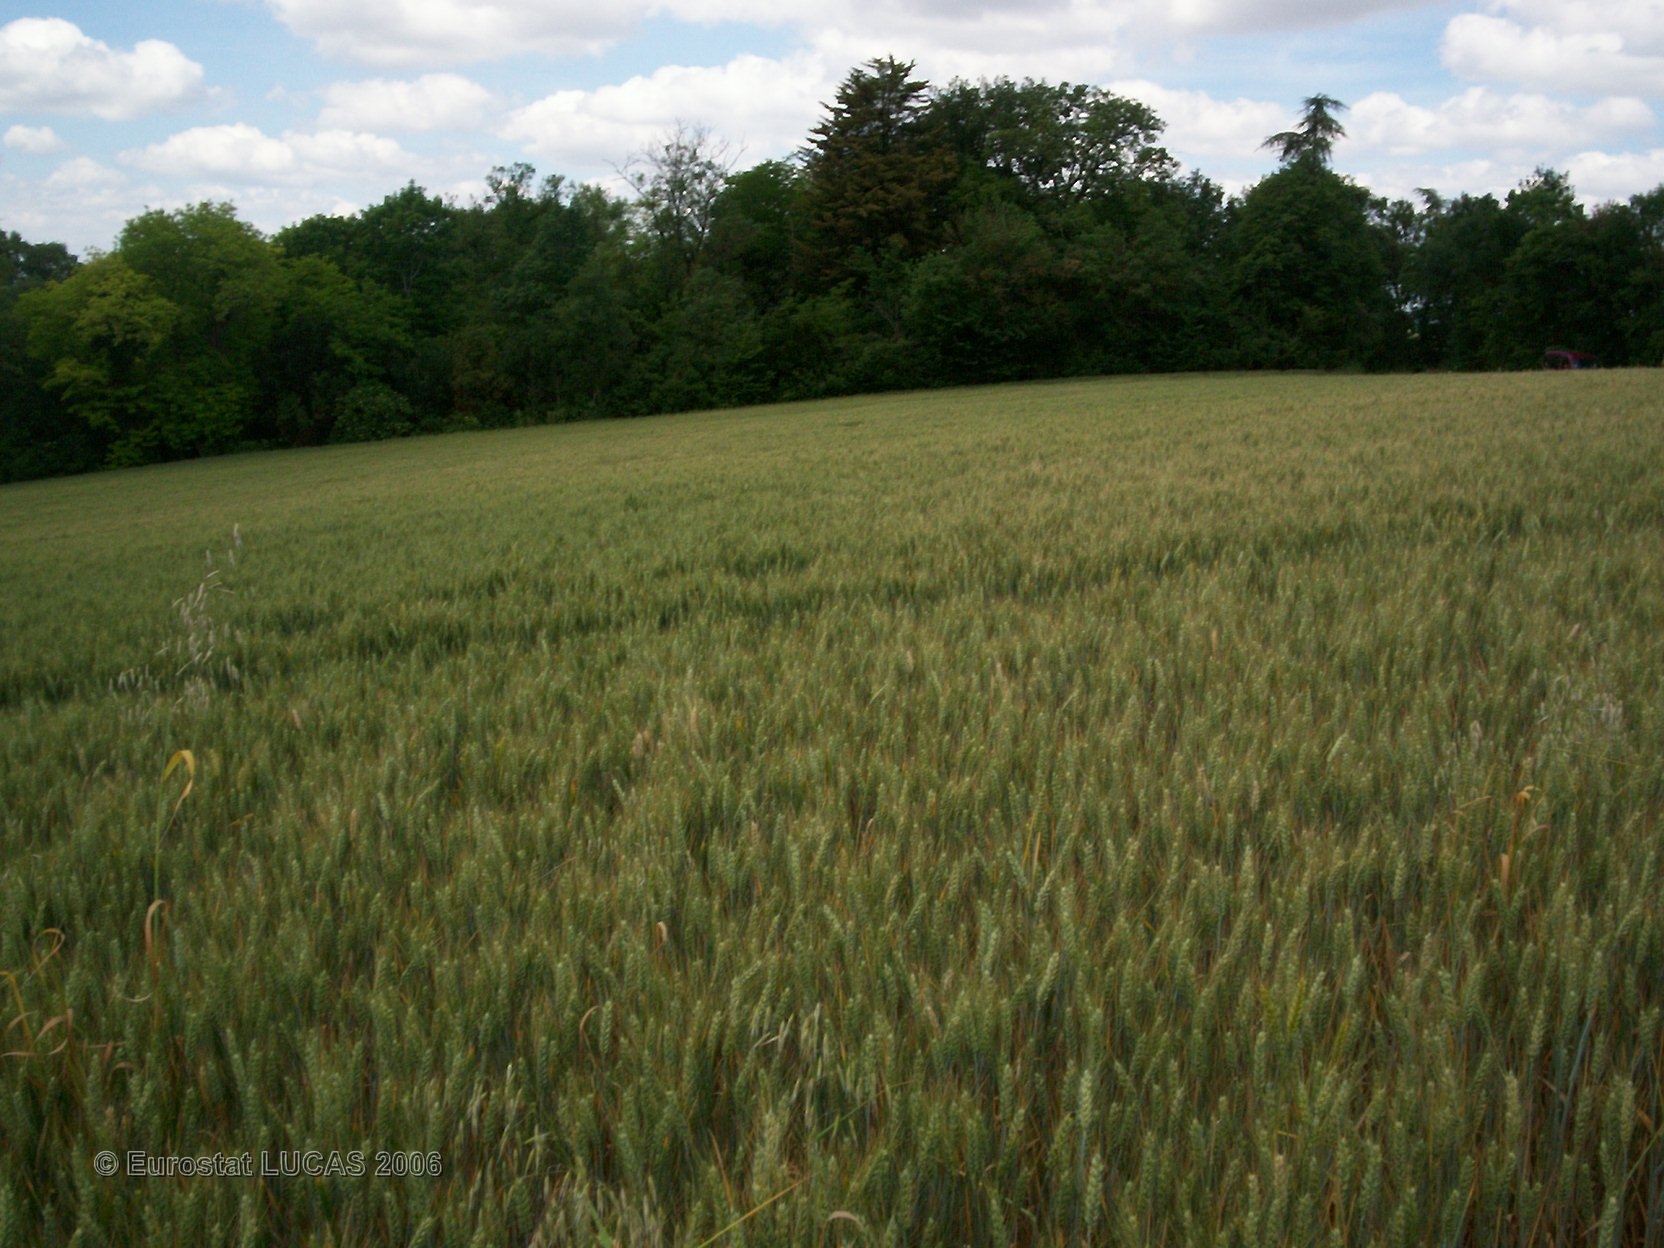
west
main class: Cropland
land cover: Common wheat
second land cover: Oats
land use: Agriculture (excluding fallow land and kitchen gardens)
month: May
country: FR
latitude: 43.4881
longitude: 1.0117
